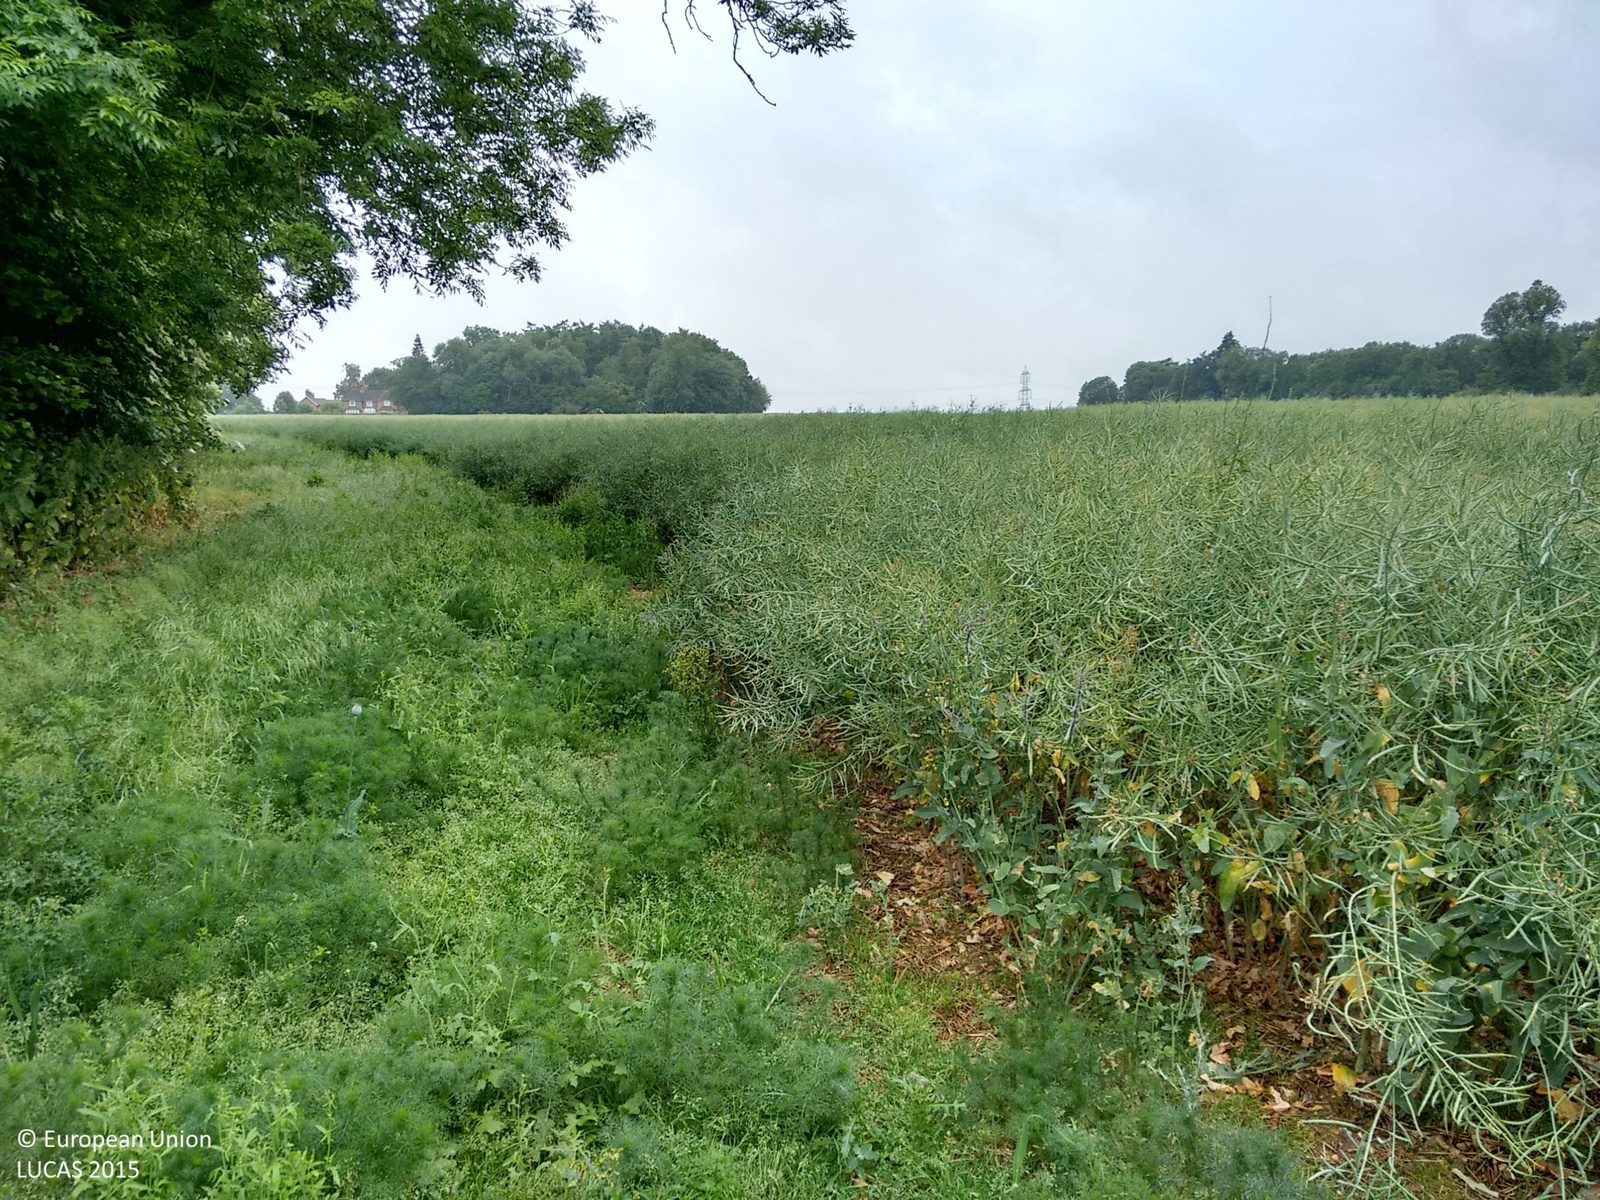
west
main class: Cropland
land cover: Rape and turnip rape
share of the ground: > 75 %
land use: Agriculture (excluding fallow land and kitchen gardens)
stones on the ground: < 10 %
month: June
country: GB
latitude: 51.4900
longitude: -1.1215
